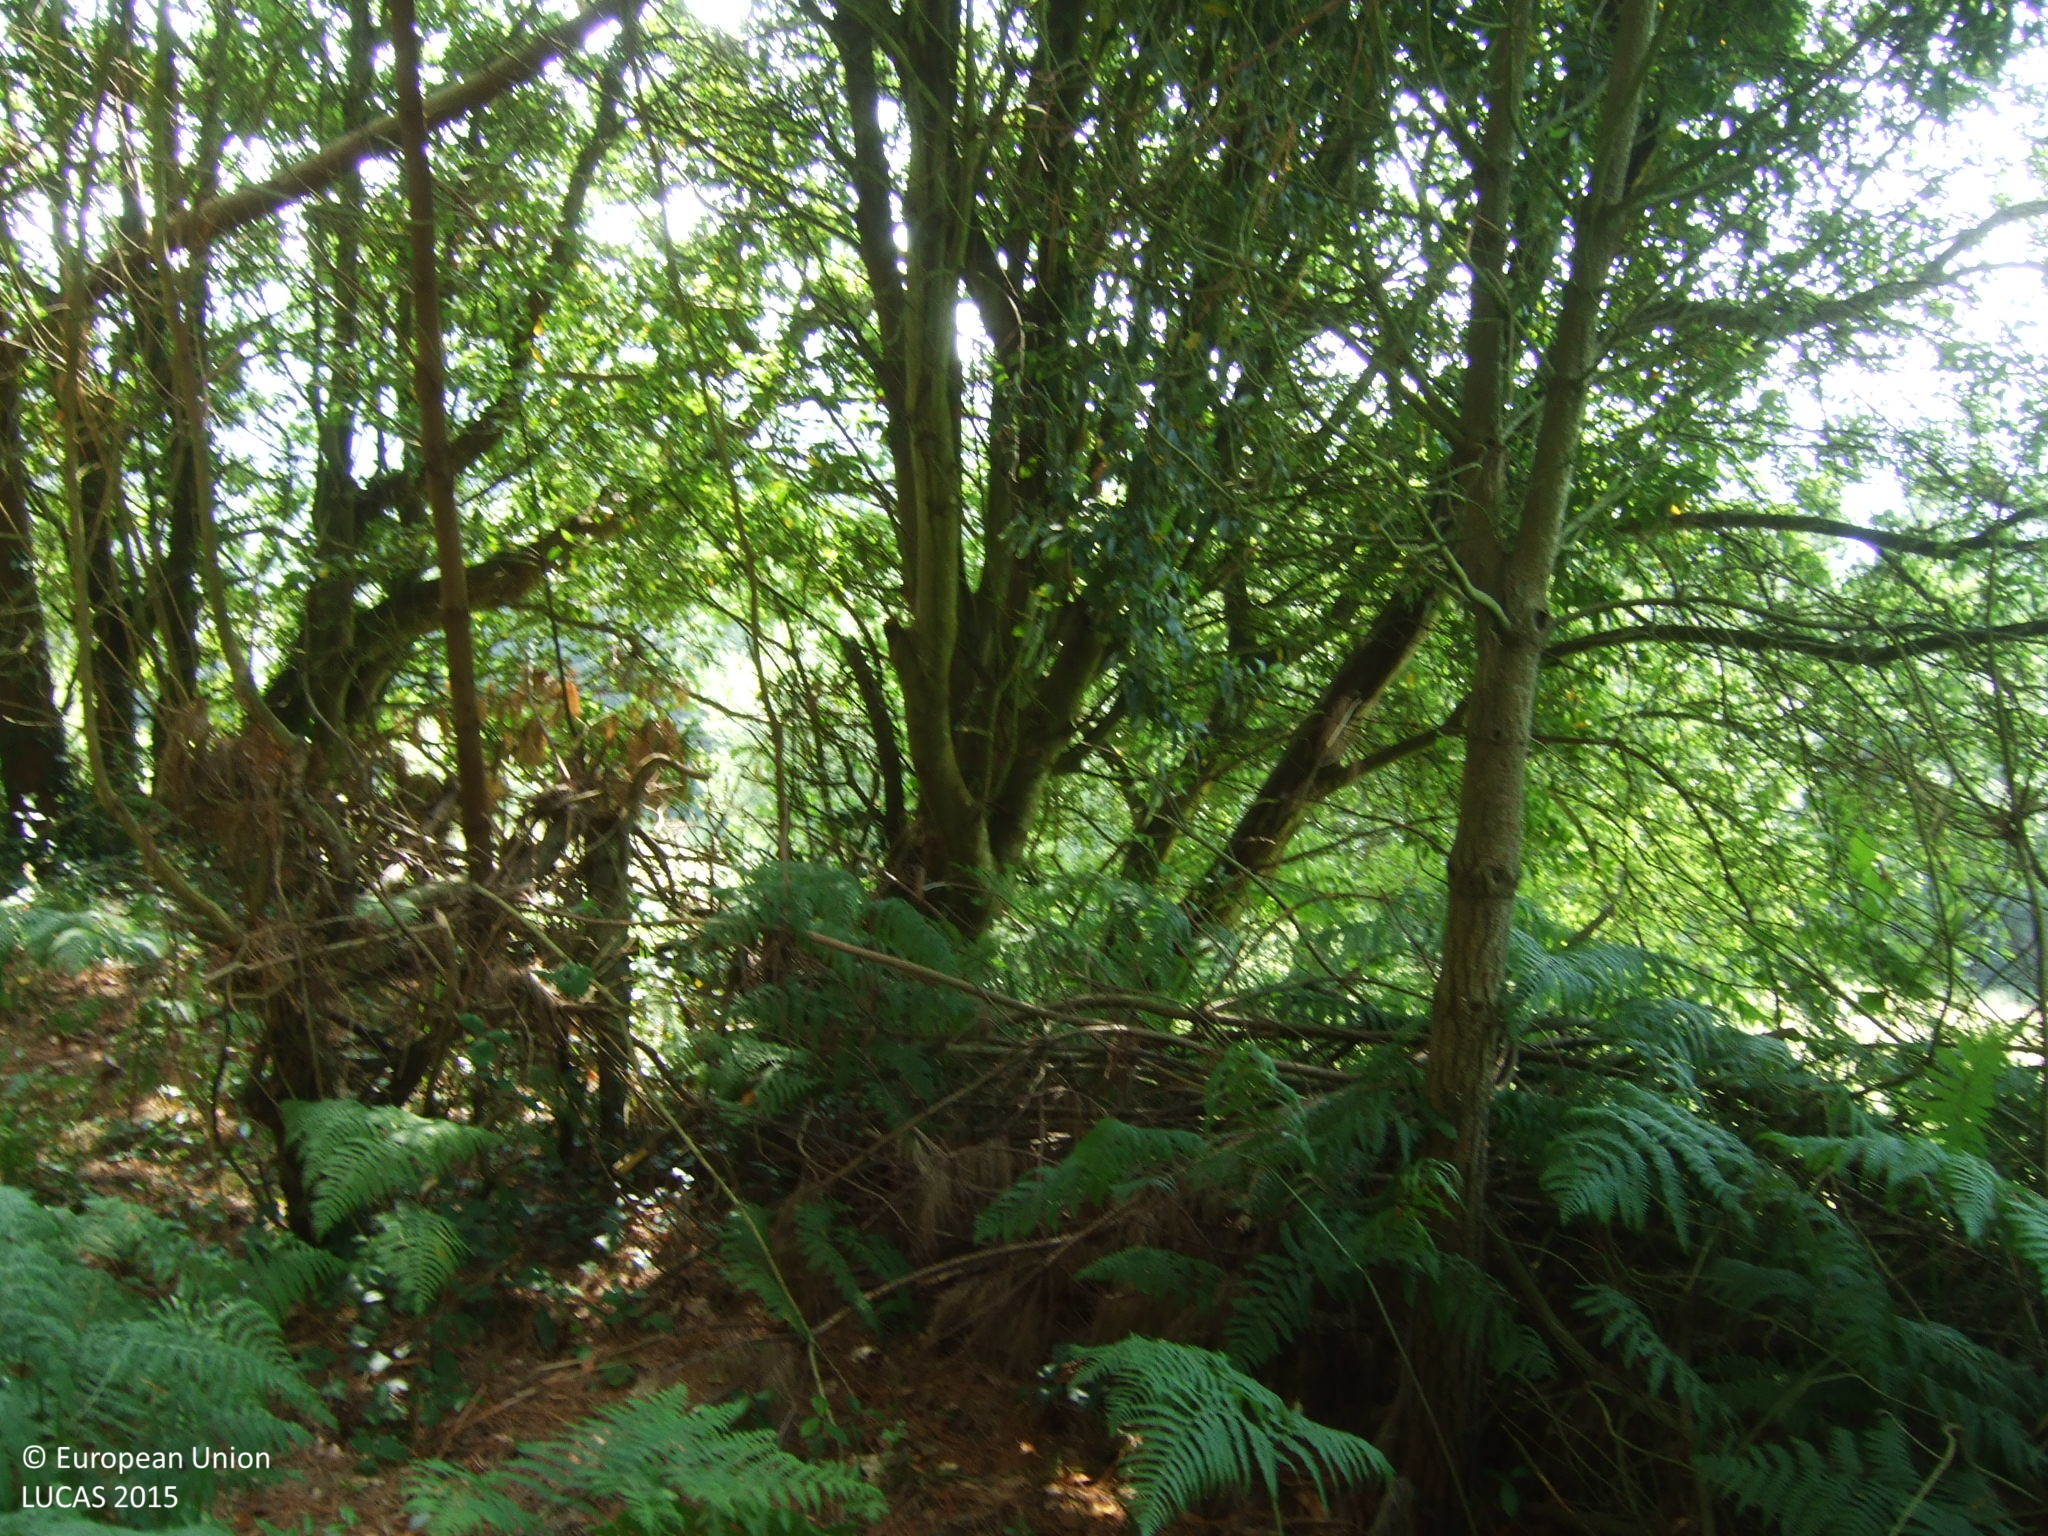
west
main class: Woodland
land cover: Pine dominated coniferous woodland
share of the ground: 50 - 75 %
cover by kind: coniferous forest trees 70 %, shrubs 15 %, unconsolidated bare surface 15 %
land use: Forestry
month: June
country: ES
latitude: 43.5938
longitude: -7.5620
